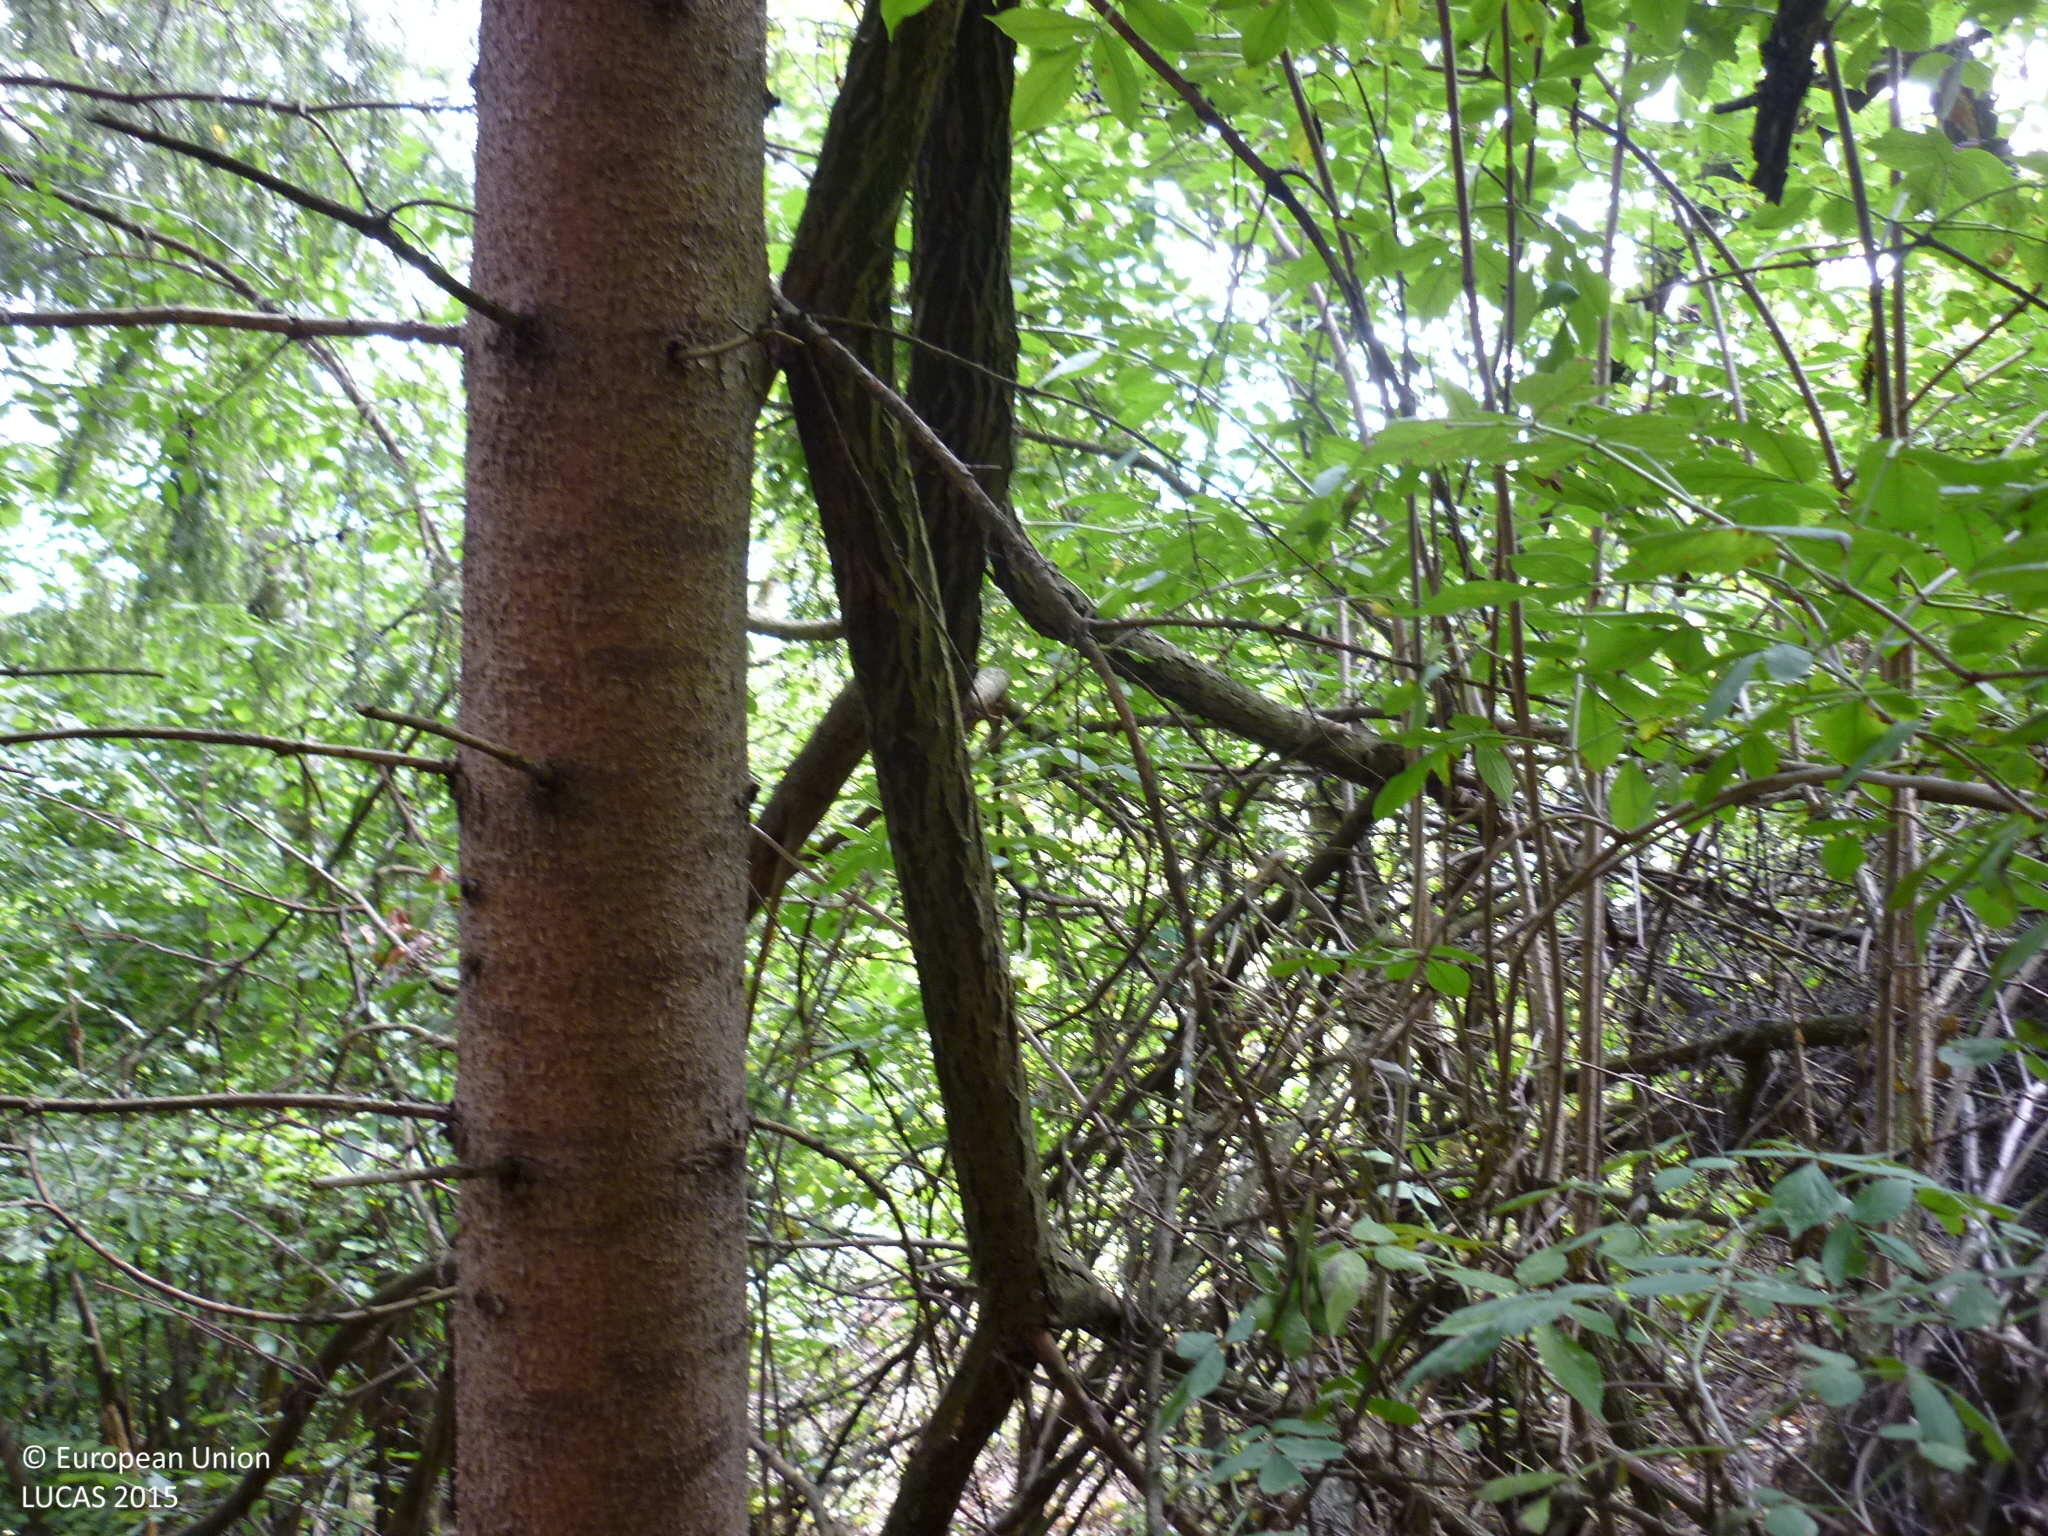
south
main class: Woodland
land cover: Spruce dominated coniferous woodland
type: alpine coniferous forest
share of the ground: > 75 %
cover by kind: coniferous forest trees 90 %, shrubs 10 %
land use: Forestry
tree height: > 5 m
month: August
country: AT
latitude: 47.4305
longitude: 15.2636
